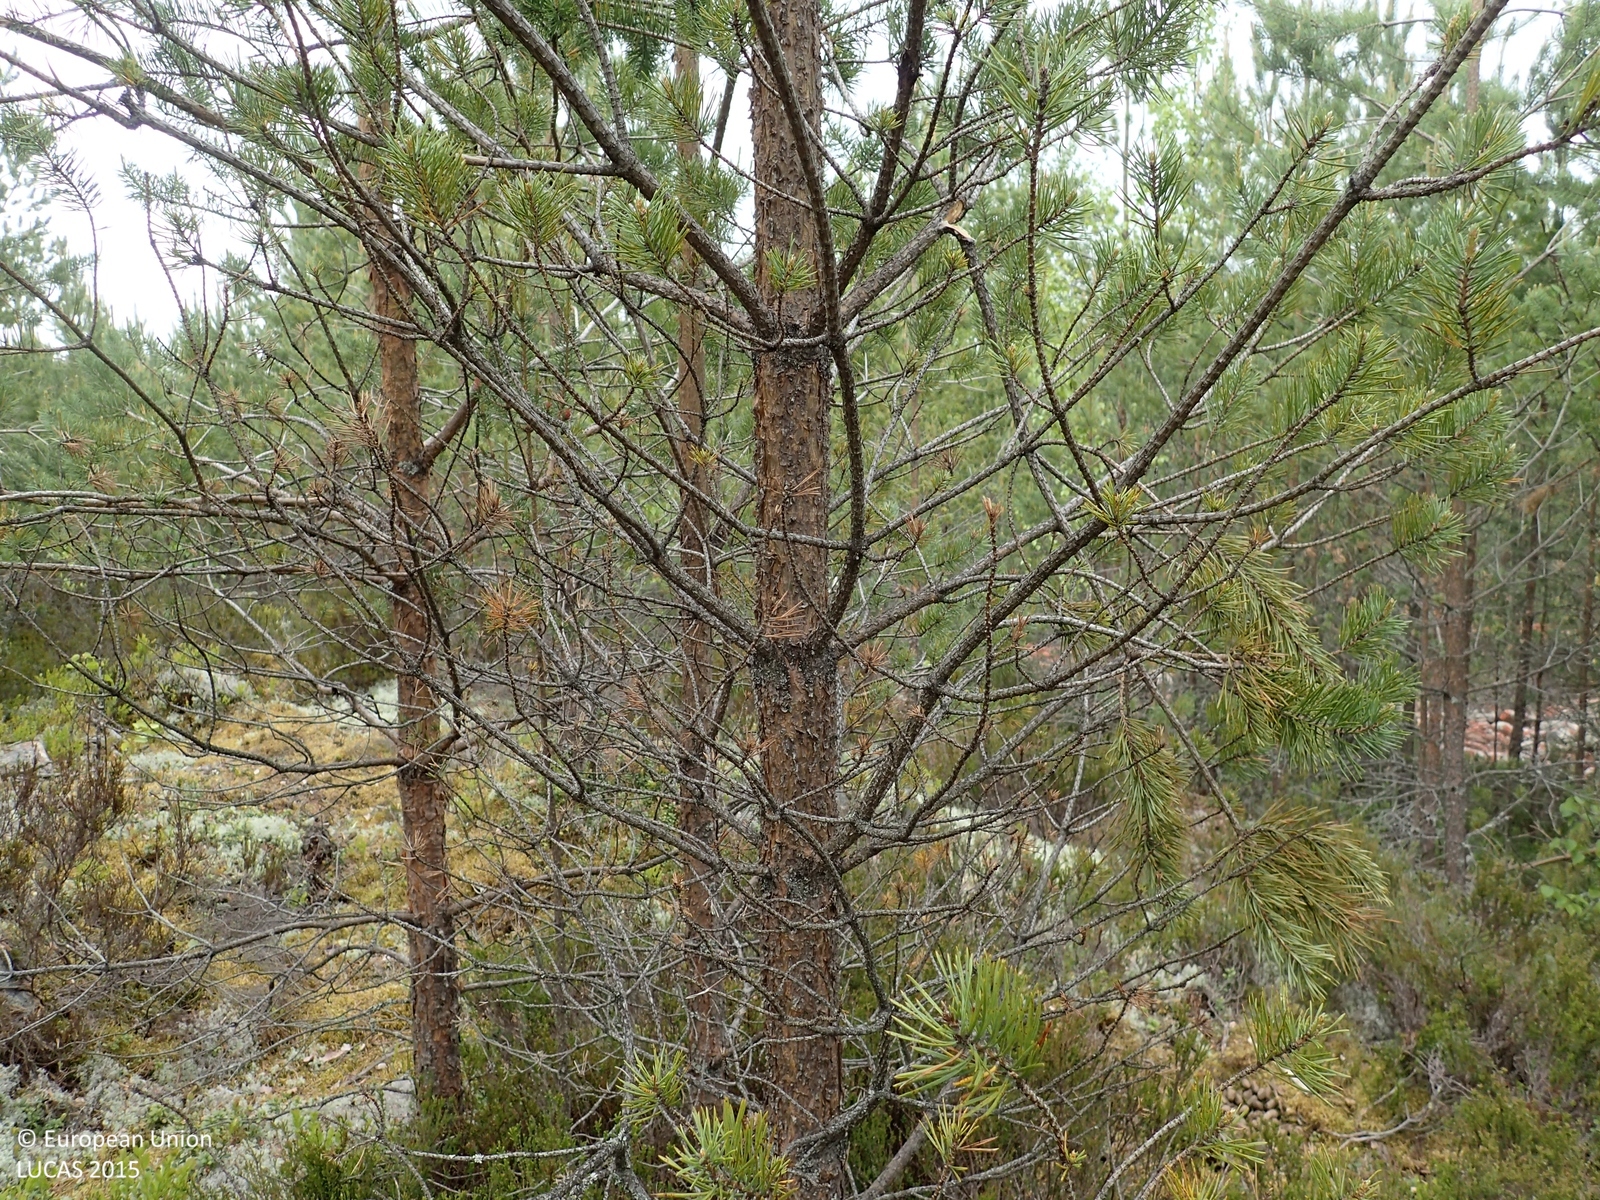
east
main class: Woodland
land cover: Pine dominated coniferous woodland
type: boreal forest
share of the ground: 50 - 75 %
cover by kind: coniferous forest trees 60 %, shrubs 25 %, broadleaved forest trees 5 %, lichens and mosses 5 %, consolidated bare surface 5 %
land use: Forestry
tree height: < 5 m
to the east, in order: Pine dominated coniferous woodland; Pine dominated mixed woodland; Pine dominated coniferous woodland; Ditches and canals; Pine dominated coniferous woodland; Ditches and canals; Pine dominated mixed woodland; Broadleaved woodland; Ditches and canals; Pine dominated coniferous woodland
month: June
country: FI
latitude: 62.4566
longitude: 22.4812
